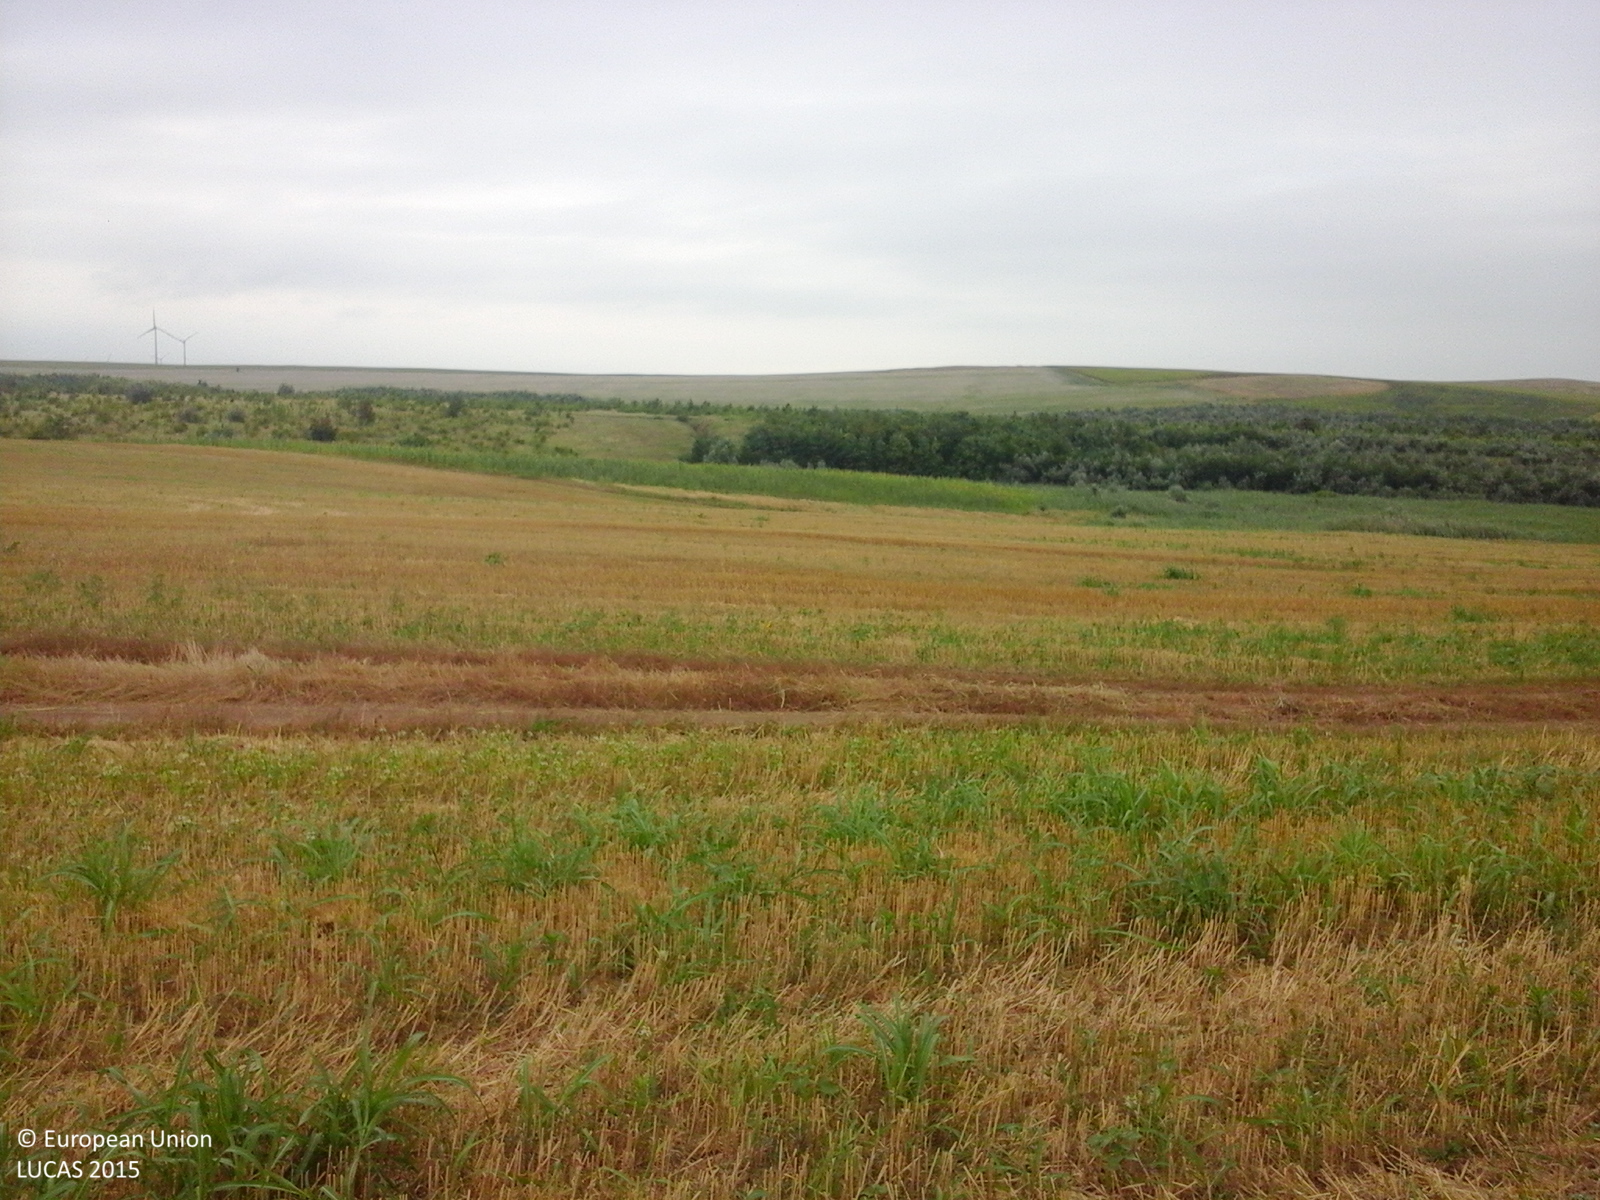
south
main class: Cropland
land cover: Durum wheat
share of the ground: 50 - 75 %
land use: Agriculture (excluding fallow land and kitchen gardens)
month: August
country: RO
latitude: 44.8424
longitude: 28.2221
